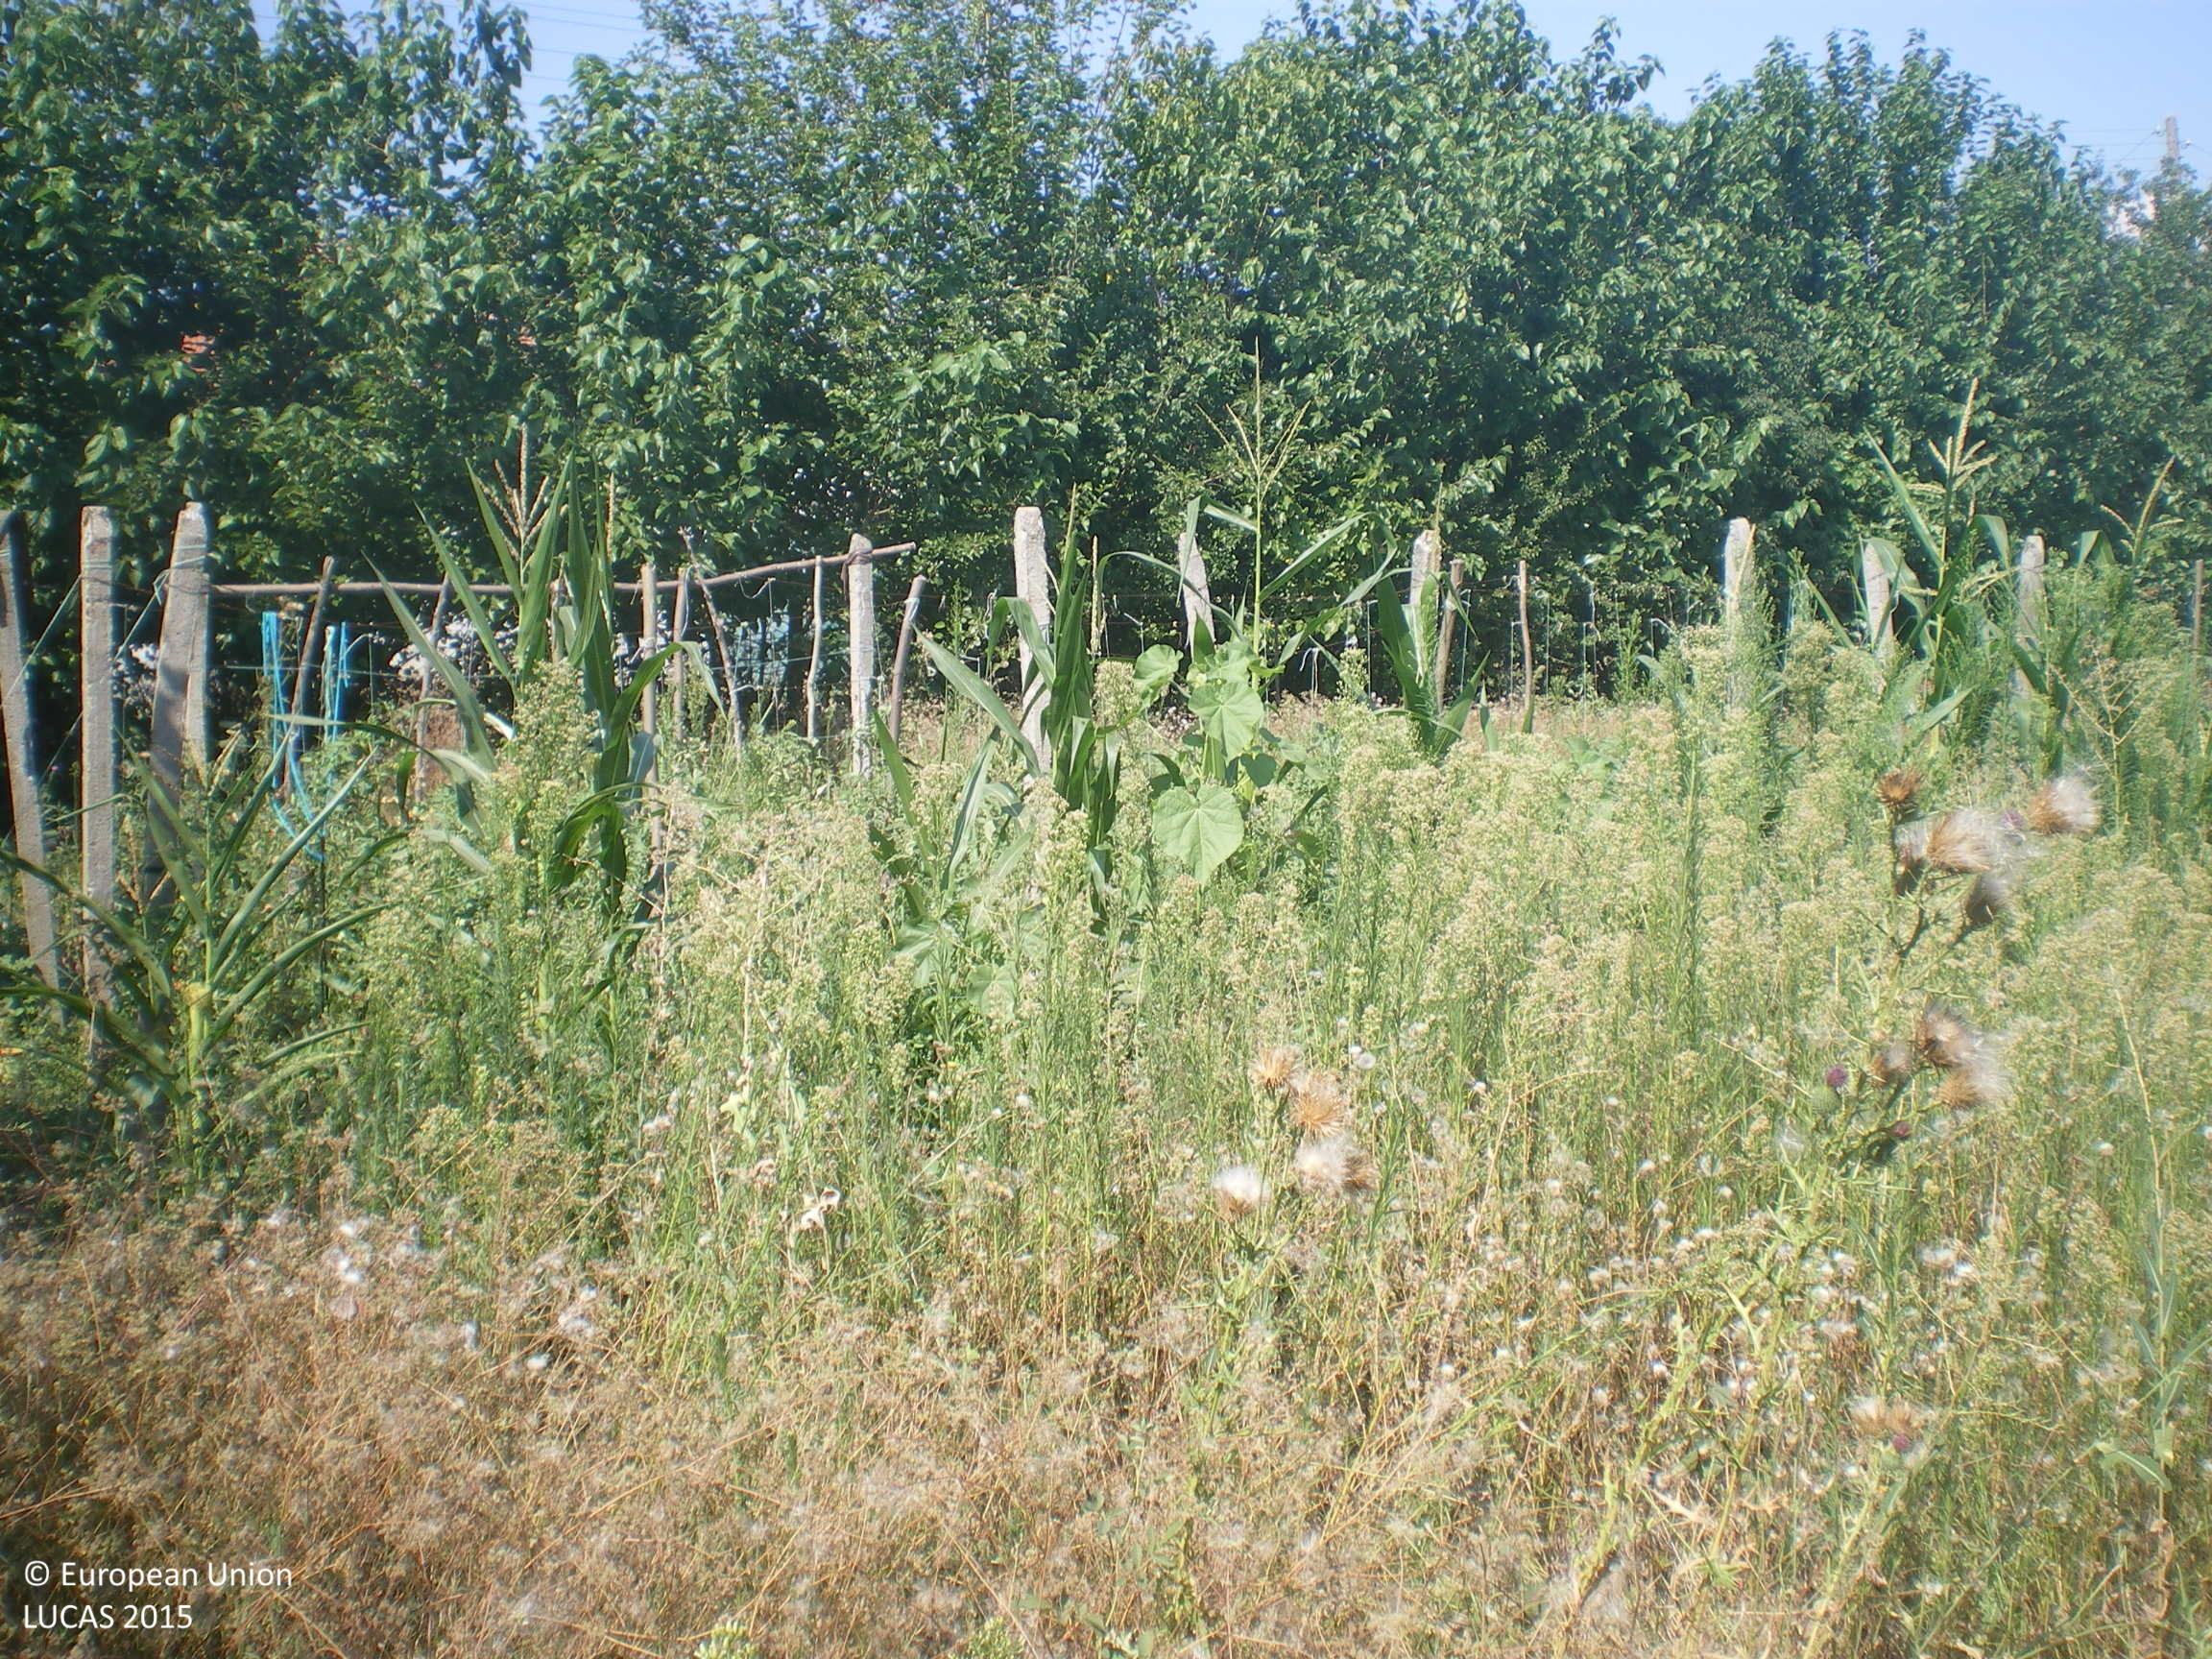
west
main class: Woodland
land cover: Broadleaved woodland
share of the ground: > 75 %
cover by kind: broadleaved forest trees 80 %, shrubs 10 %, herbaceous plants 10 %
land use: Residential
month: August
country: BG
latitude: 42.3362
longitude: 25.7171
